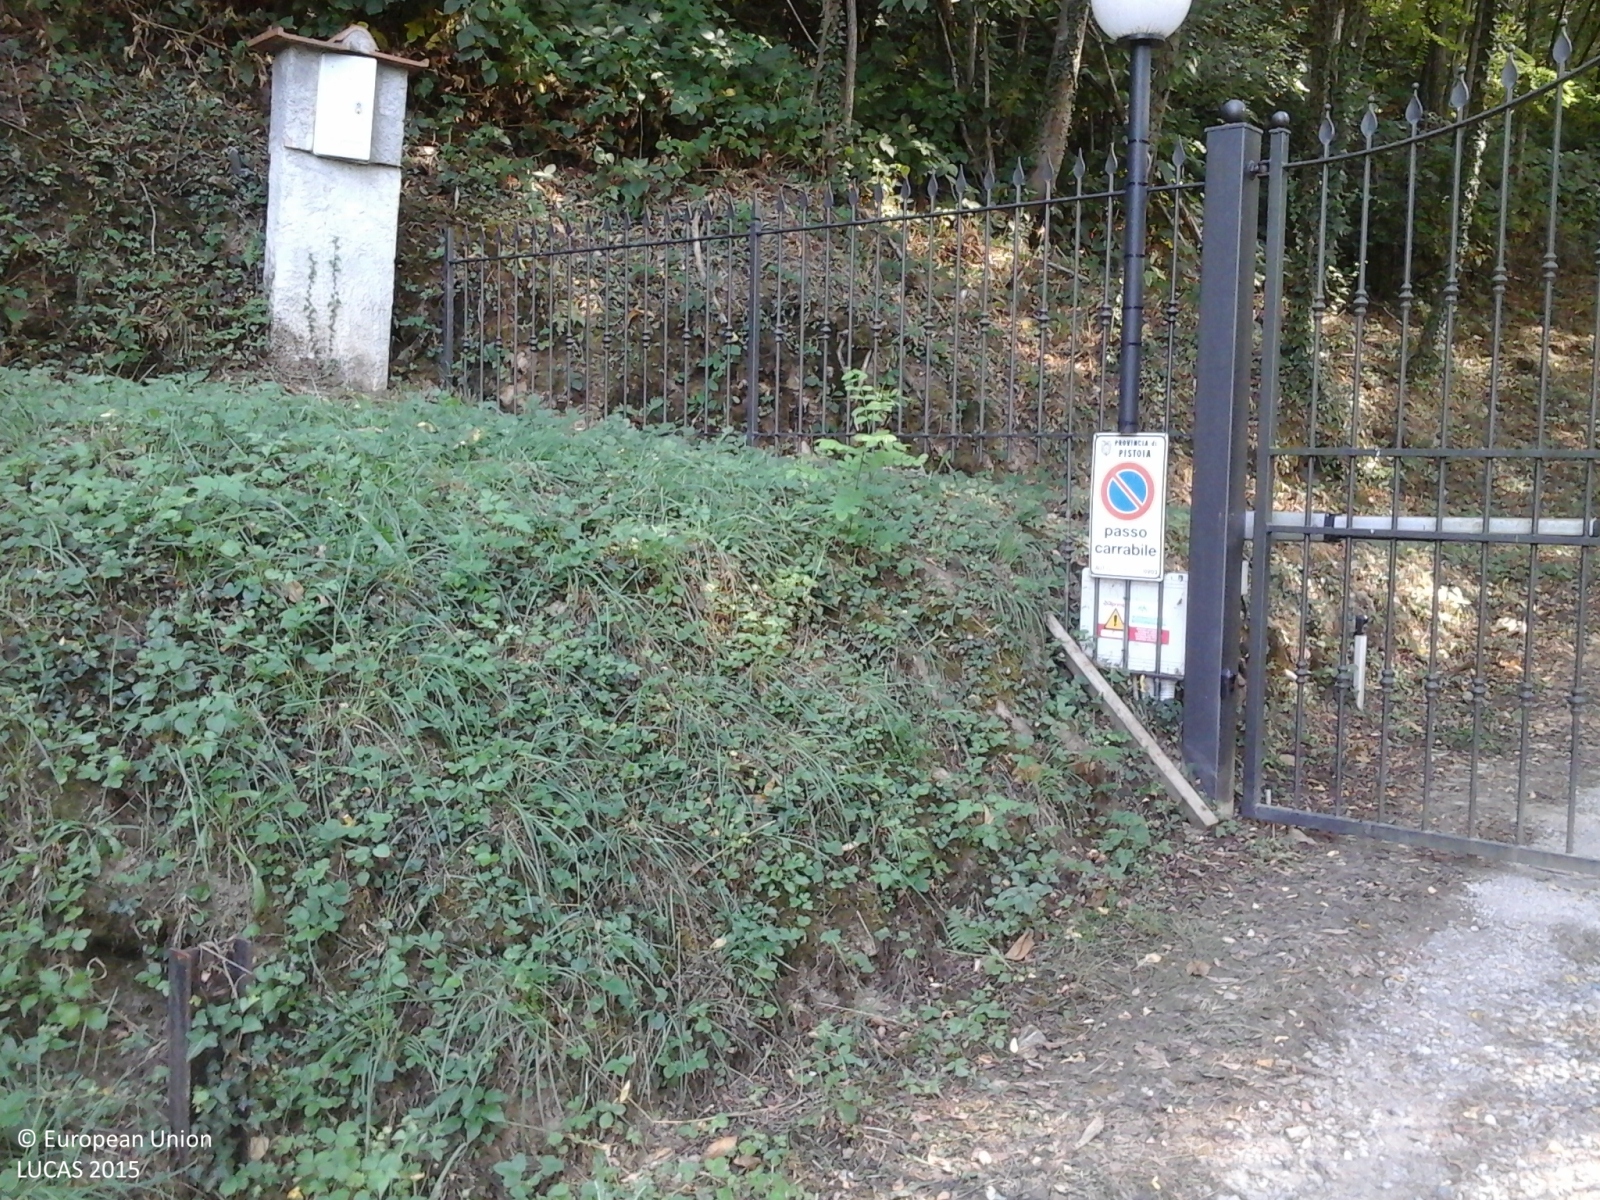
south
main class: Woodland
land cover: Broadleaved woodland
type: thermophilous deciduous forest
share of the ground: > 75 %
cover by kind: broadleaved forest trees 100 %
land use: Forestry
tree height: > 5 m
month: August
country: IT
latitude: 43.9332
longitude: 10.7082
